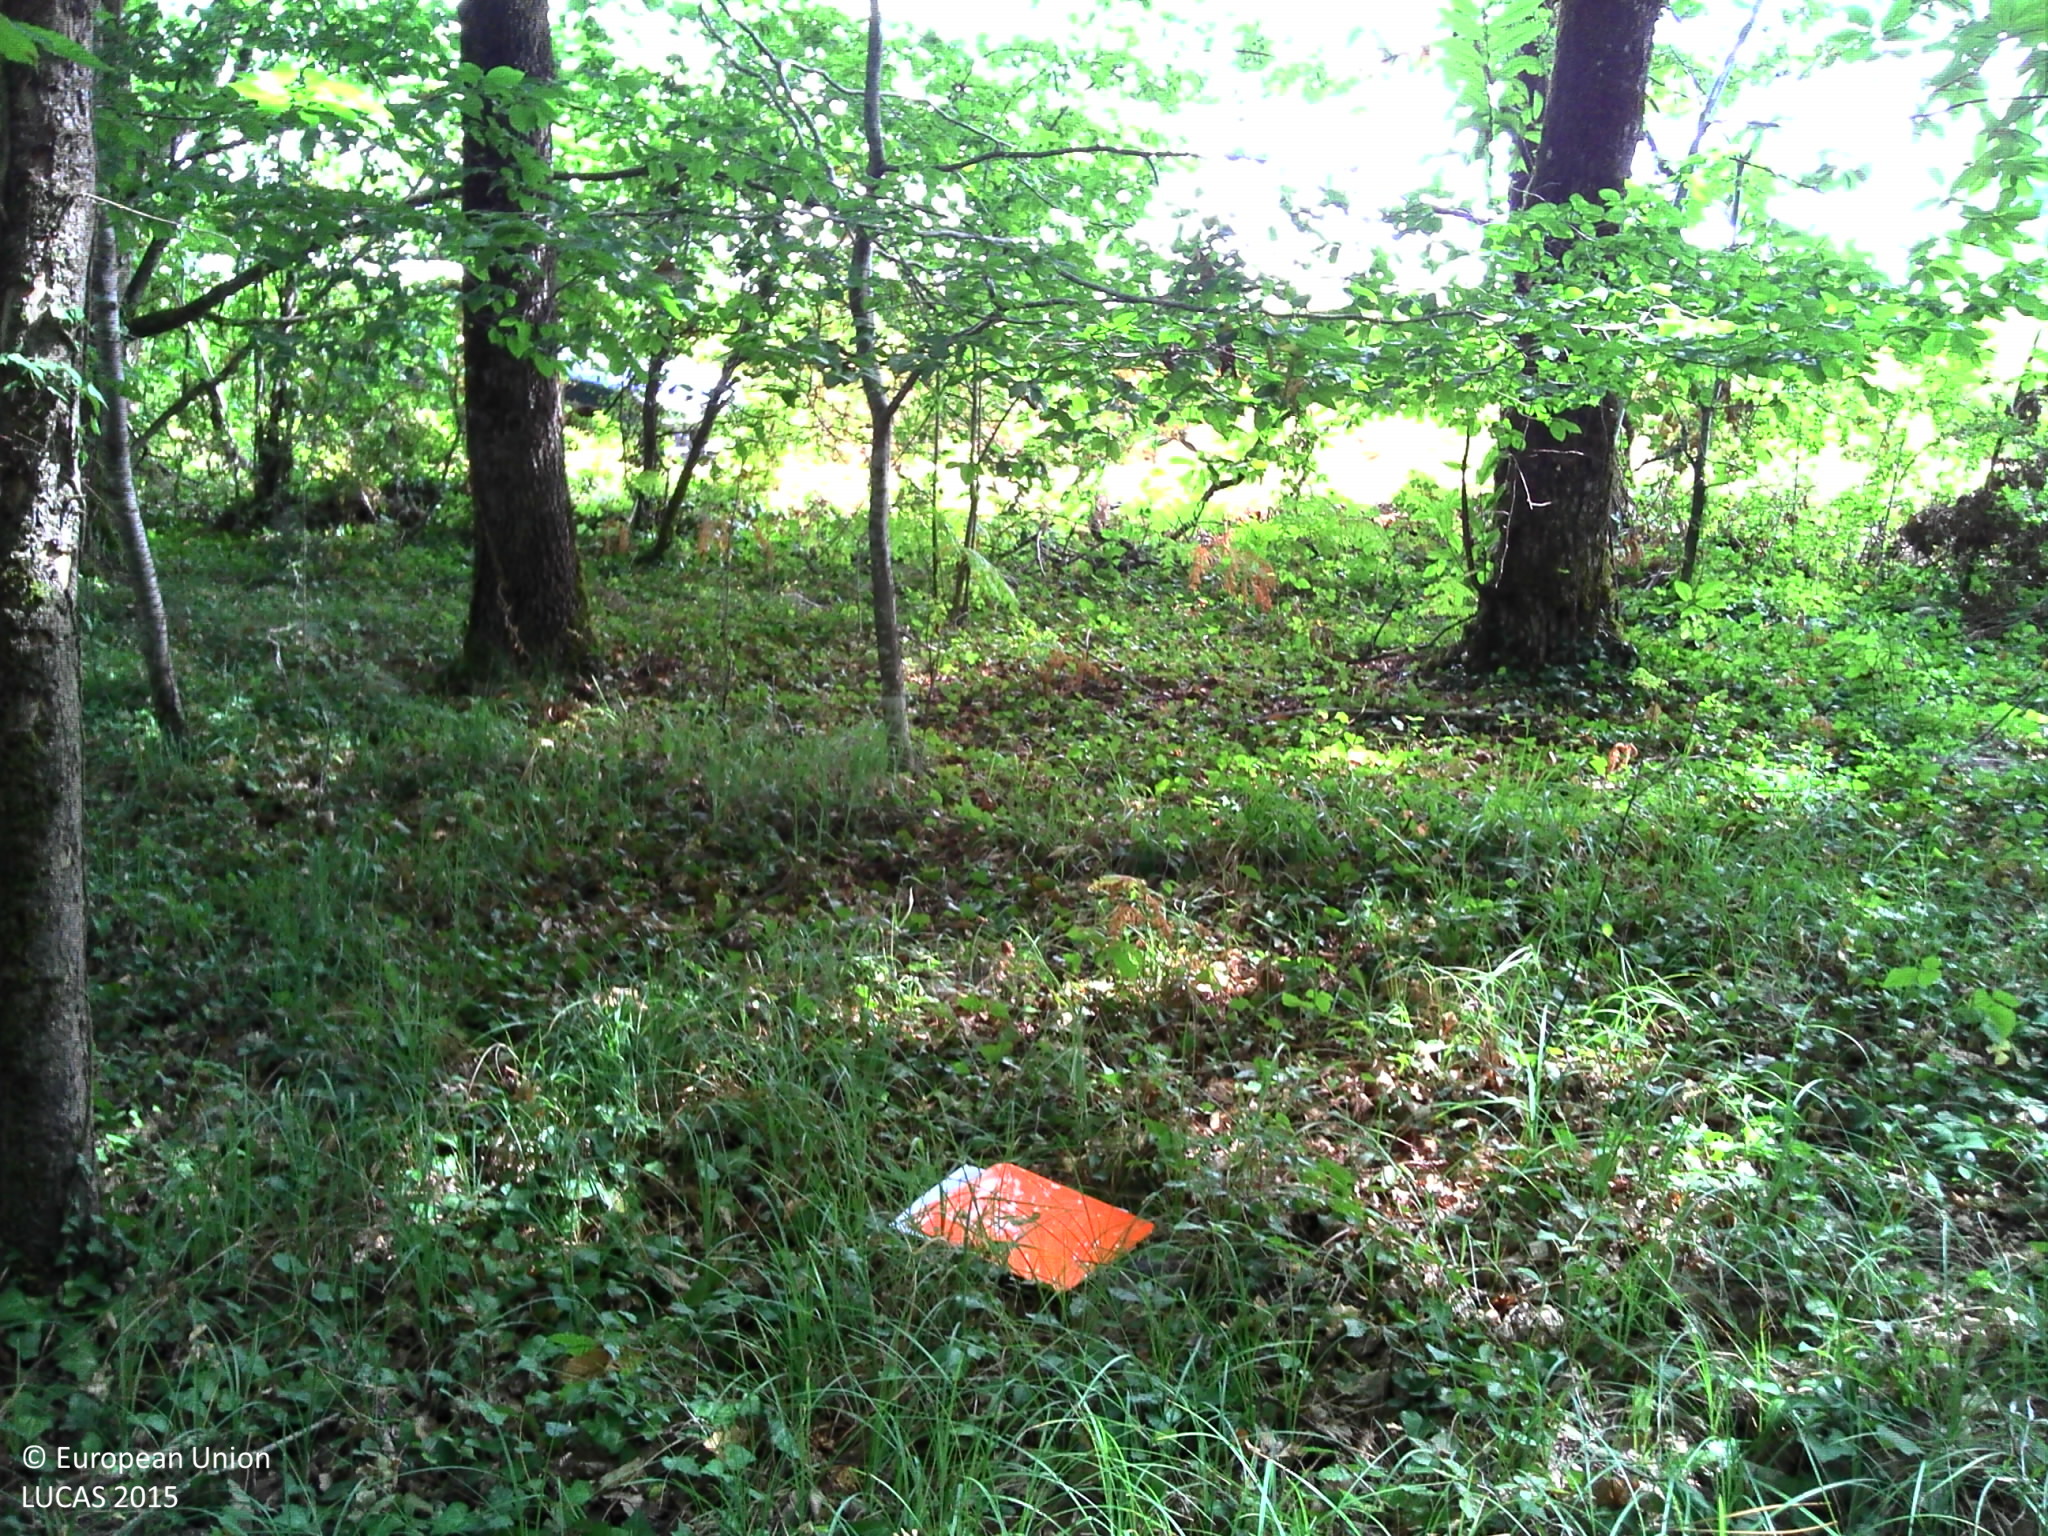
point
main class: Woodland
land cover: Broadleaved woodland
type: thermophilous deciduous forest
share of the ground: > 75 %
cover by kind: broadleaved forest trees 80 %, herbaceous plants 10 %, shrubs 5 %, lichens and mosses 5 %
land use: Forestry
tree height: > 5 m
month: July
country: FR
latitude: 44.9056
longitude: 0.8355
